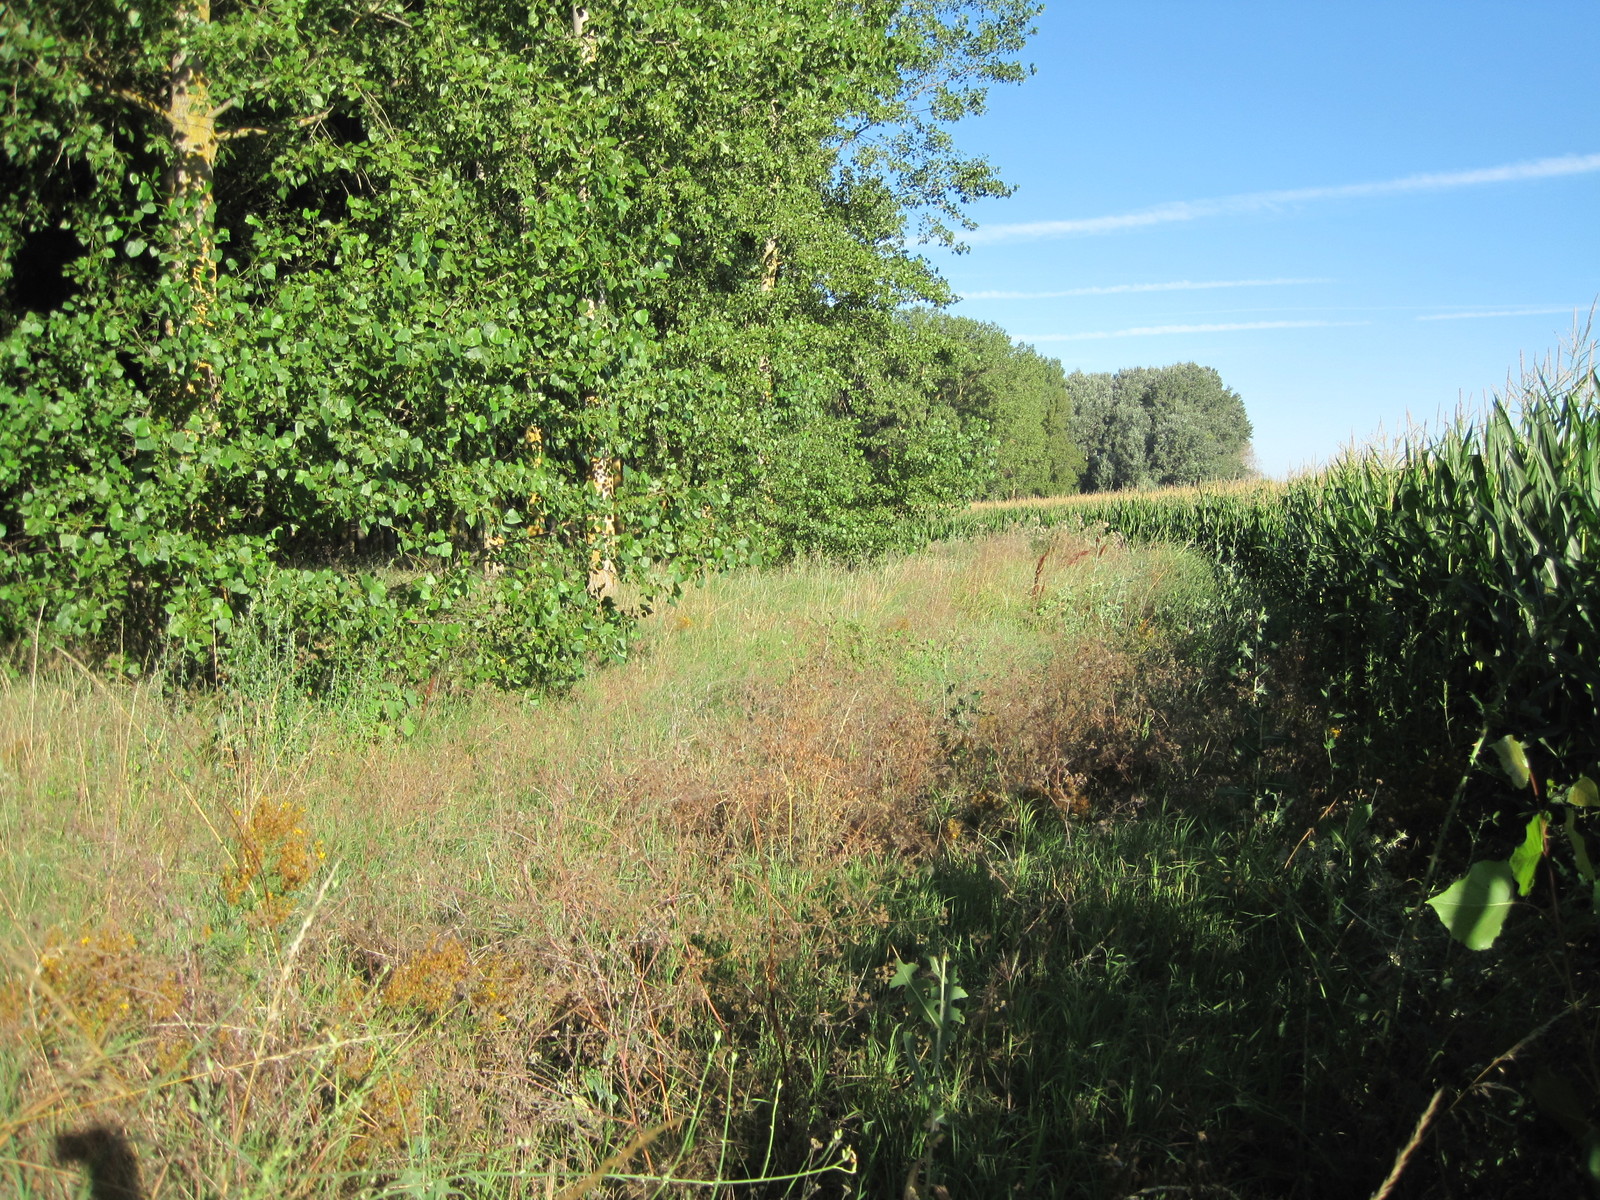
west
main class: Cropland
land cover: Maize
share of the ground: > 75 %
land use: Agriculture (excluding fallow land and kitchen gardens)
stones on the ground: < 10 %
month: July
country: ES
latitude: 42.0050
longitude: -5.6051
